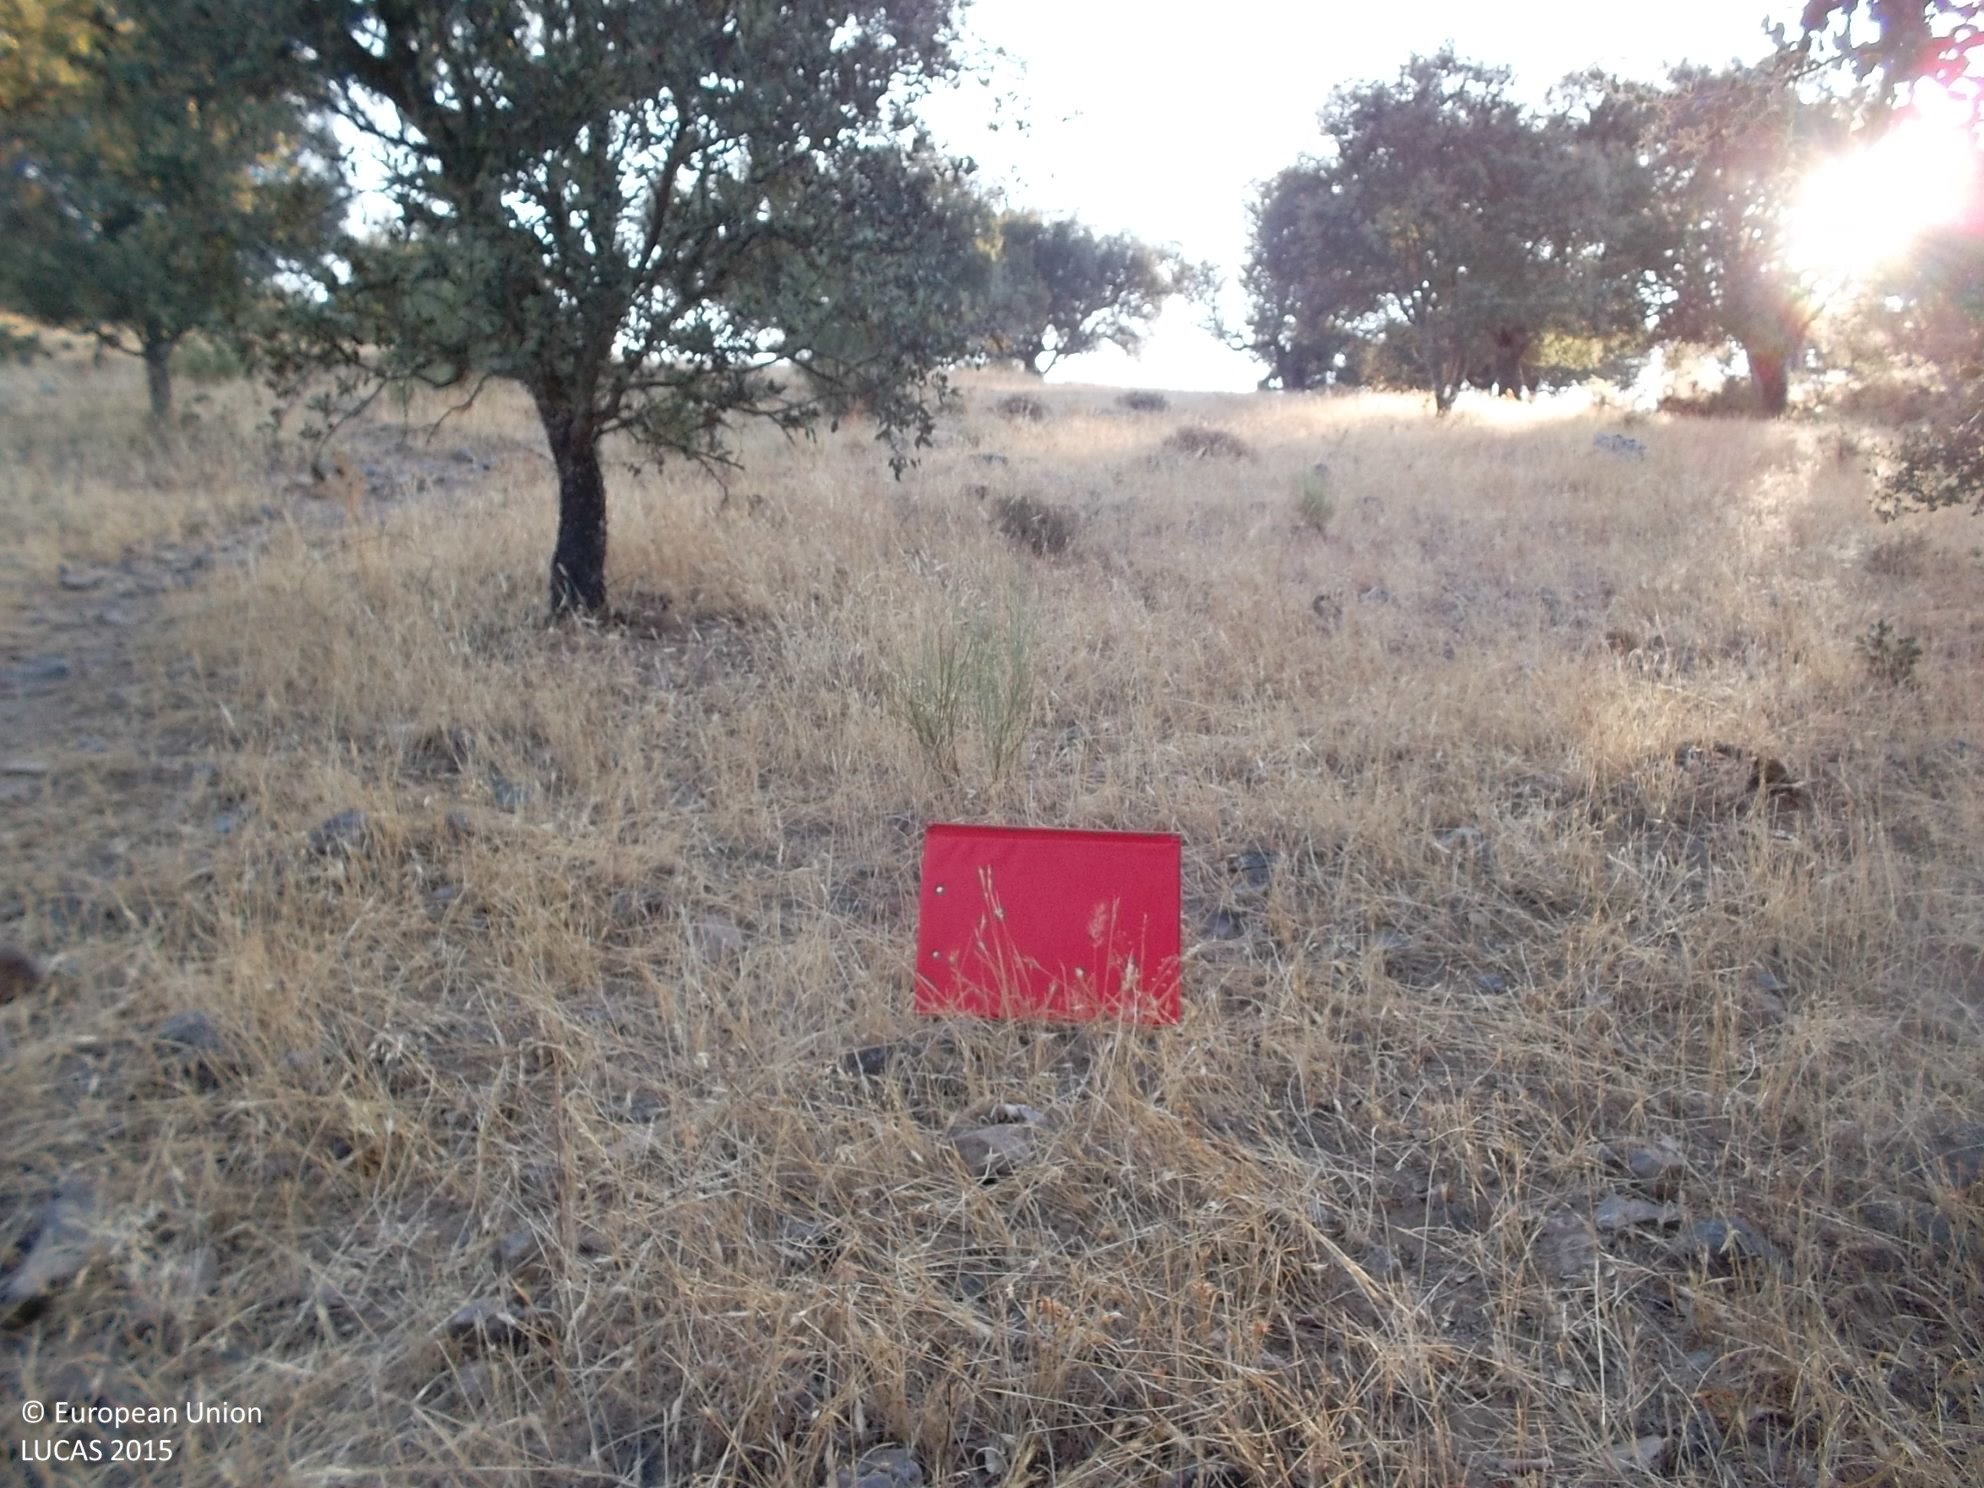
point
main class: Woodland
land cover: Broadleaved woodland
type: broadleaved evergreen forest
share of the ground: 50 - 75 %
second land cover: Grassland without tree/shrub cover
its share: > 75 %
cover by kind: broadleaved forest trees 50 %, herbaceous plants 50 %
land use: Forestry
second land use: Agriculture (excluding fallow land and kitchen gardens)
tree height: < 5 m
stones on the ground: 10 - 25 %
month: August
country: ES
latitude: 38.1151
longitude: -6.6446
